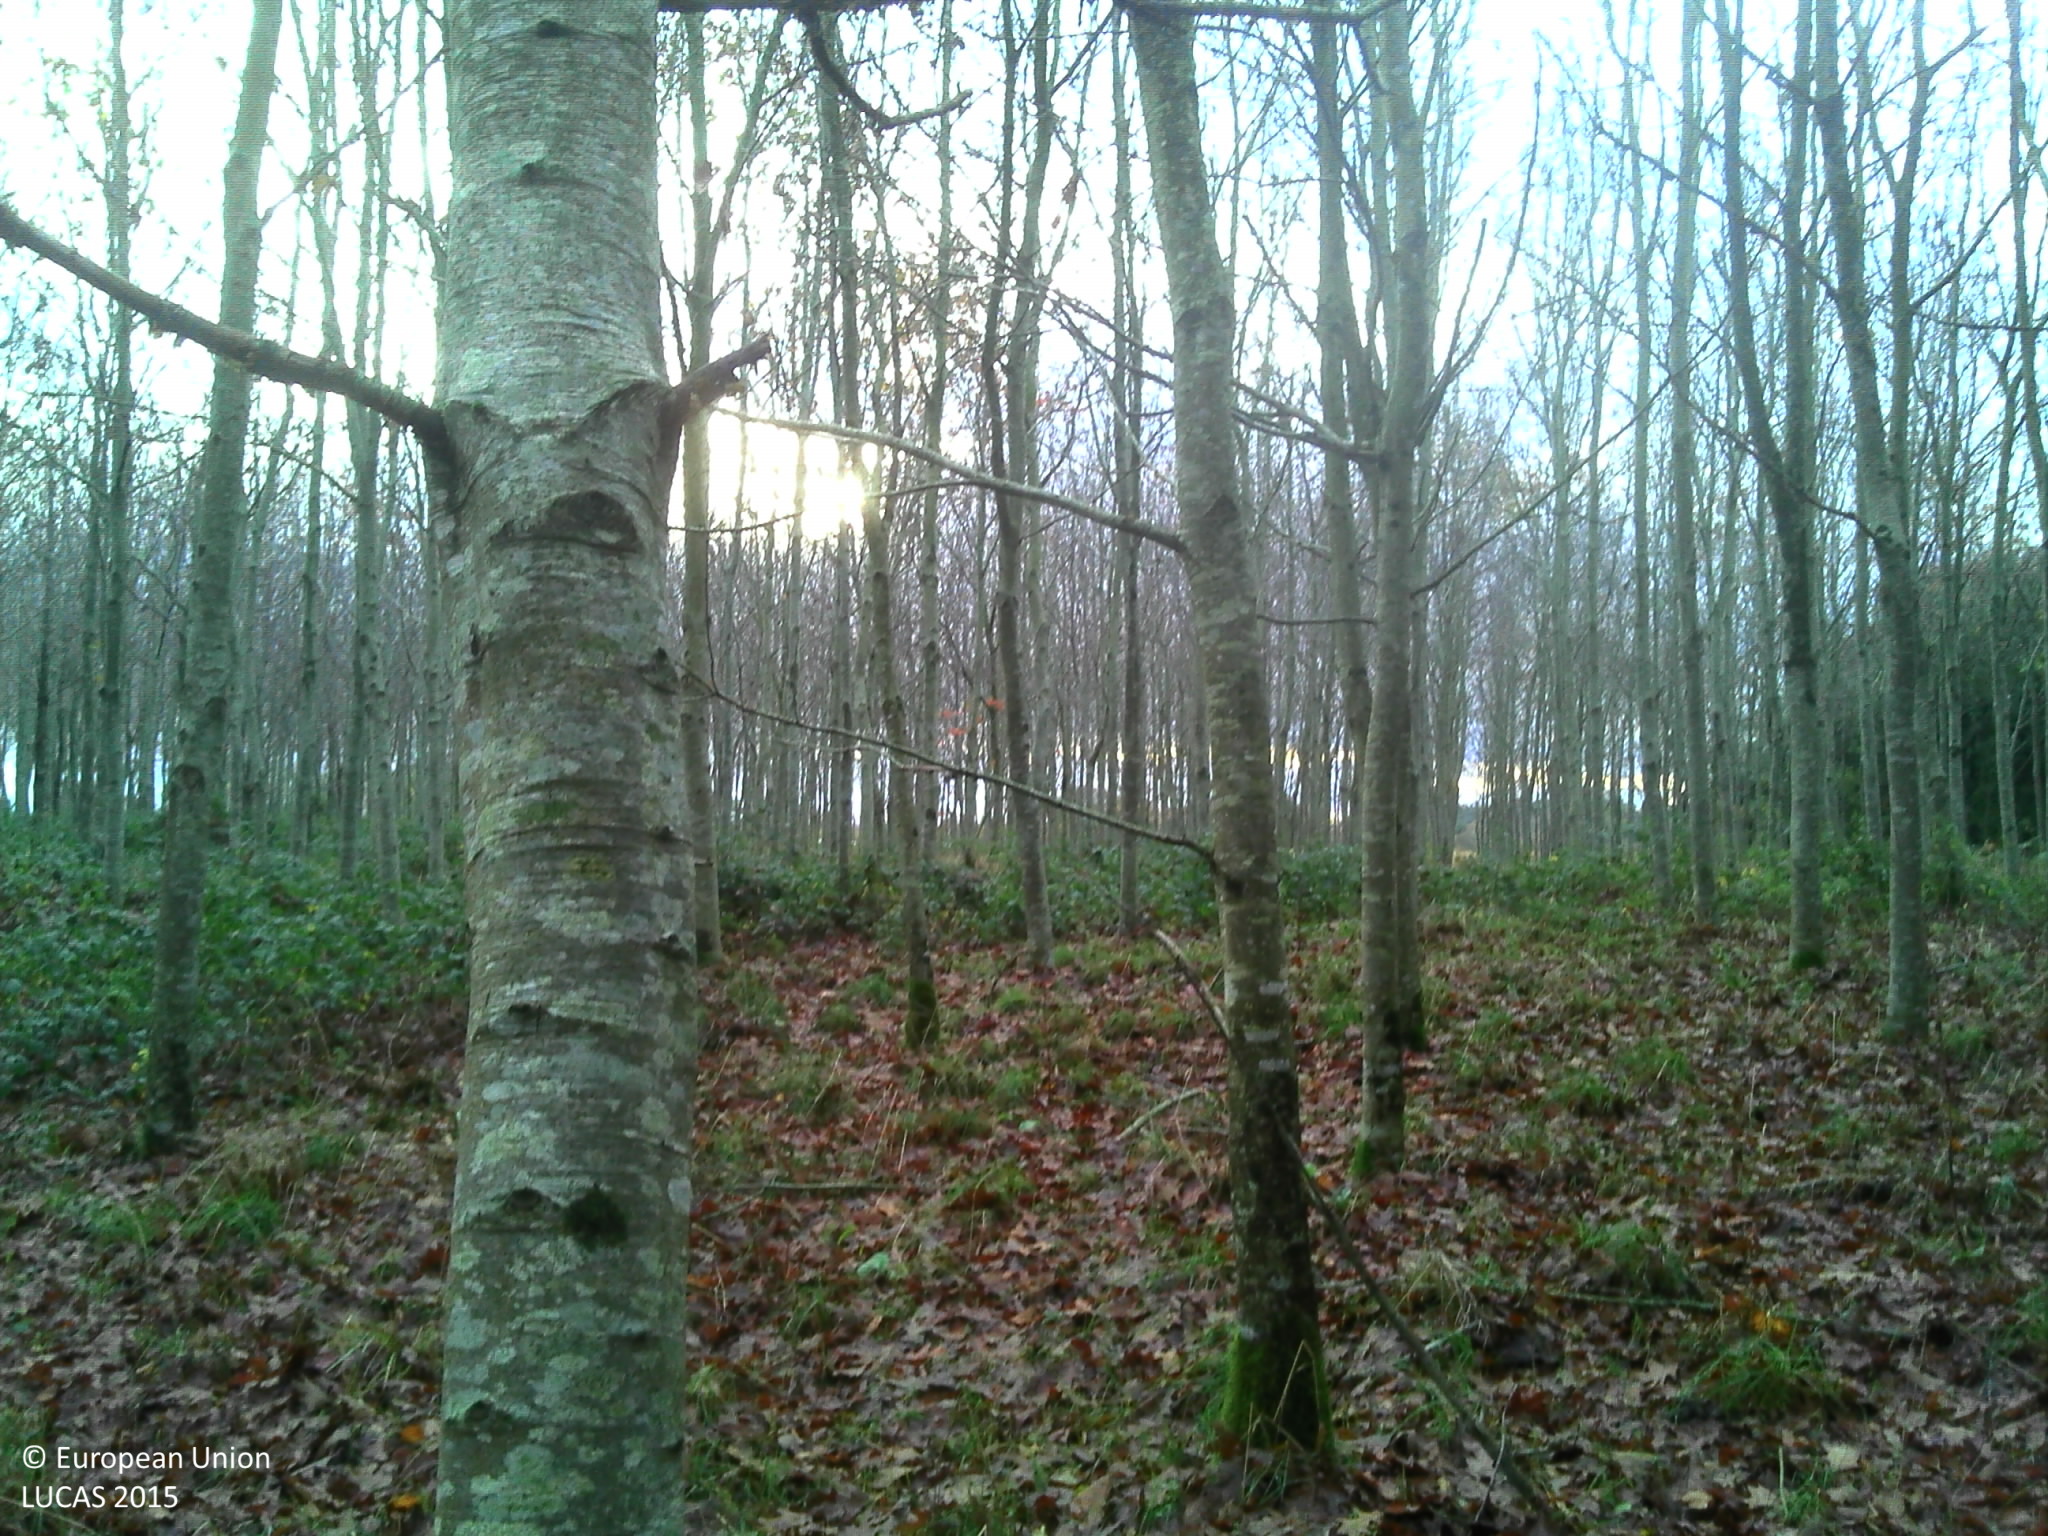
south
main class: Woodland
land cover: Broadleaved woodland
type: exotic forest
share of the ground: > 75 %
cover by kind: broadleaved forest trees 100 %
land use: Forestry
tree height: > 5 m
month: November
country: FR
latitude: 48.0111
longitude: -3.3316
